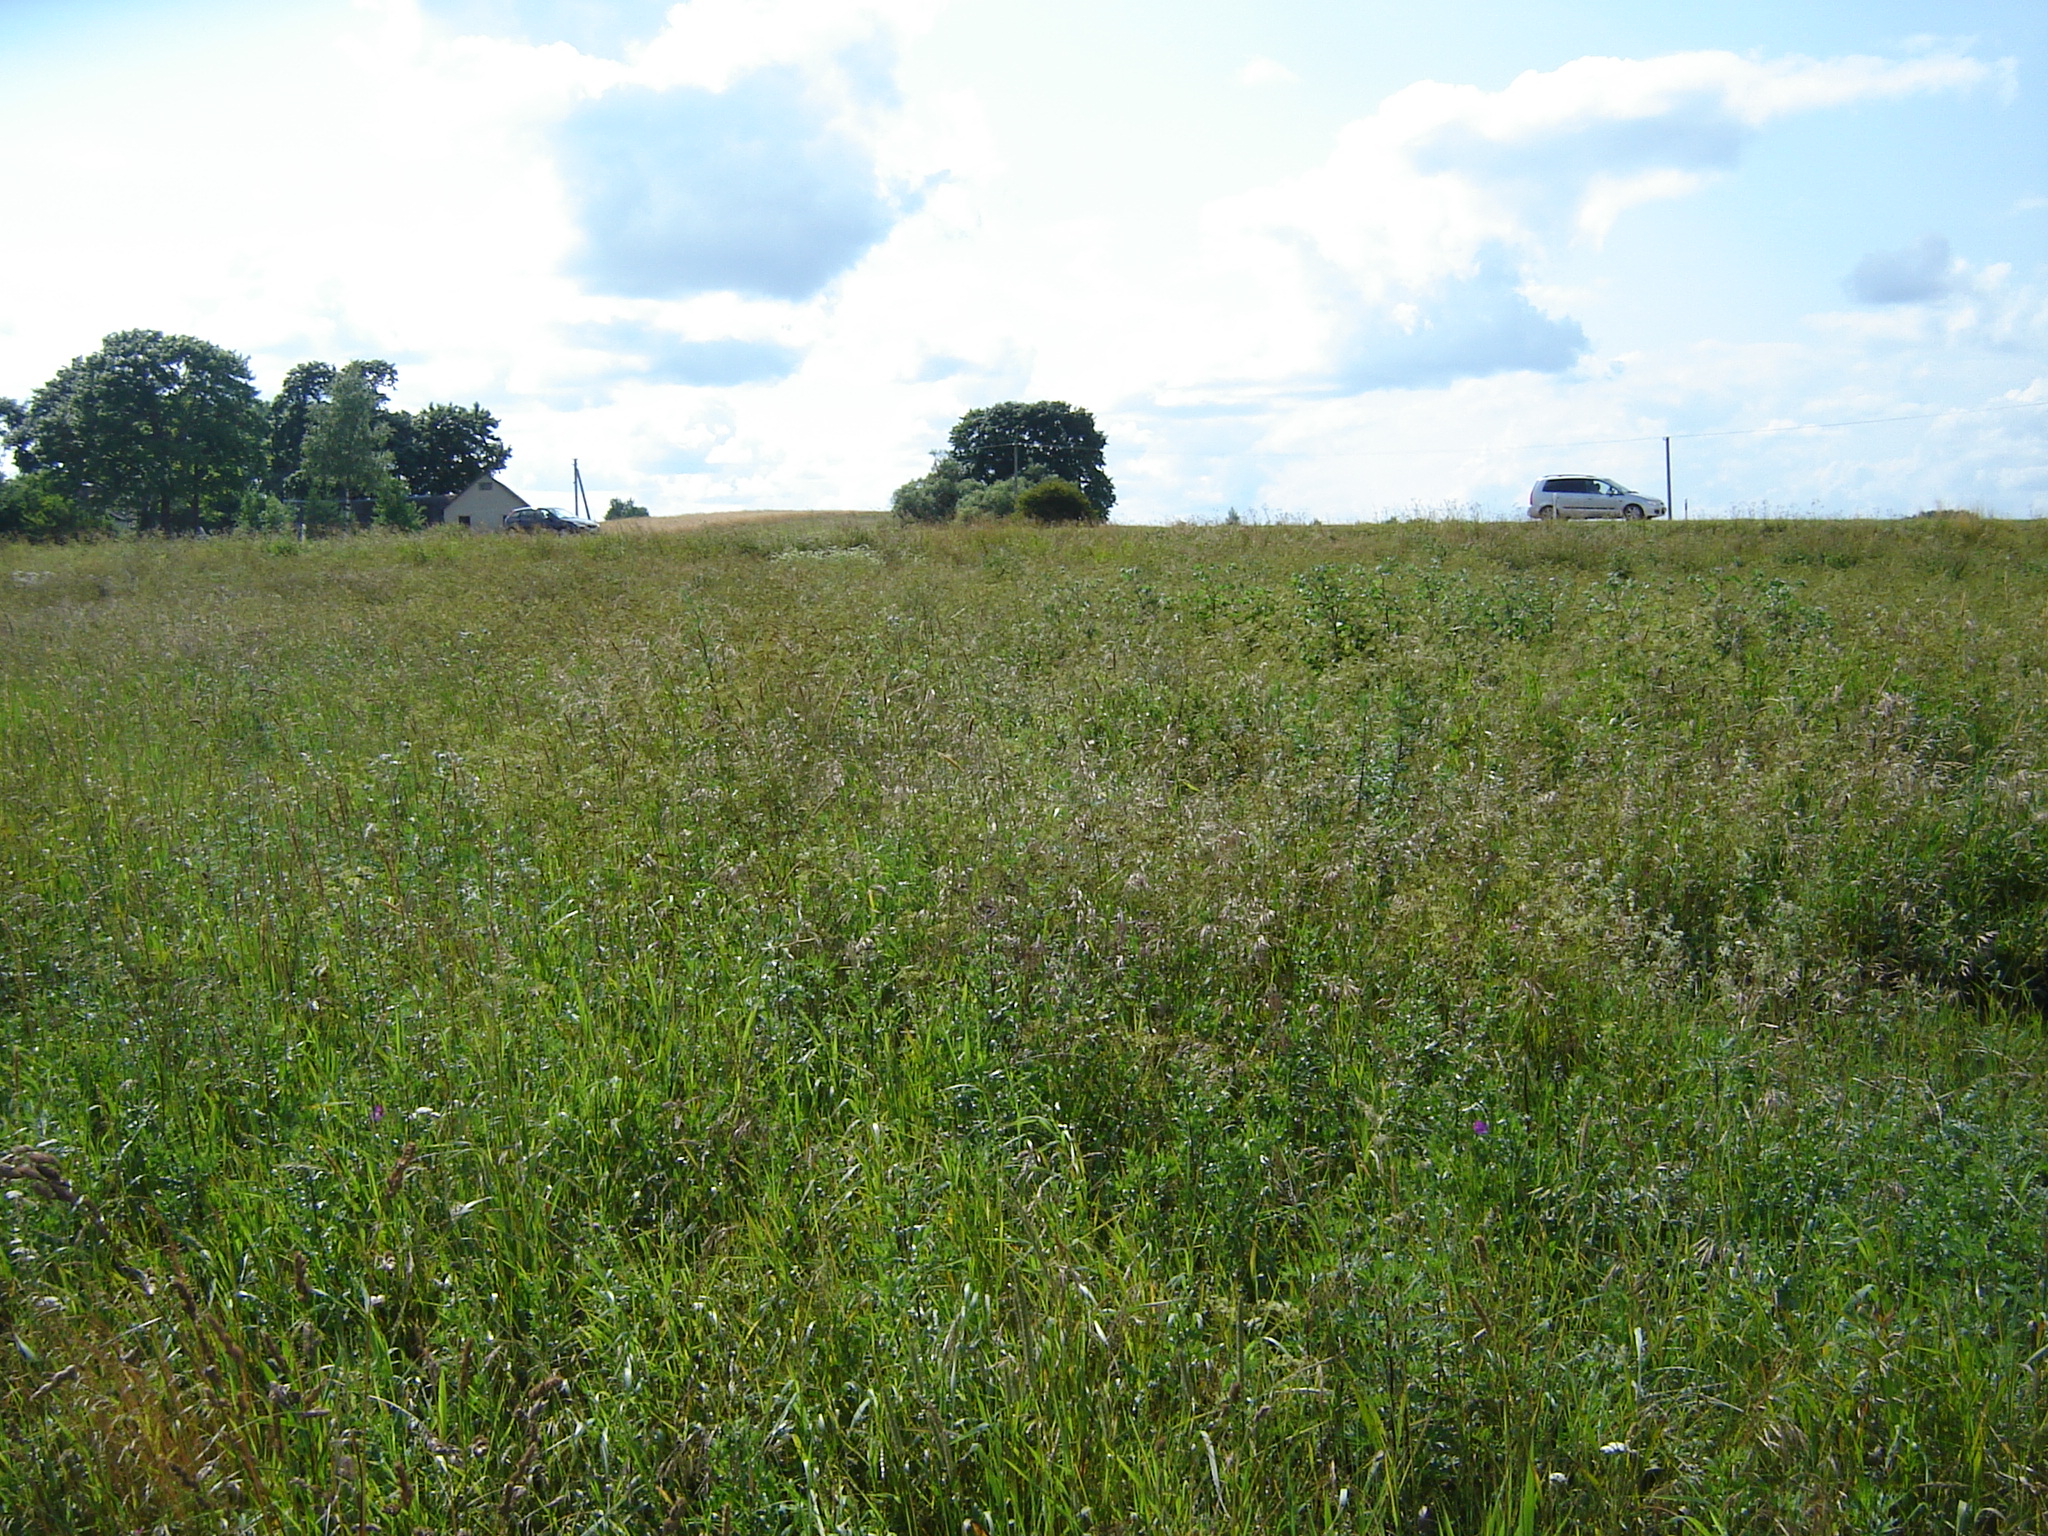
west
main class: Grassland
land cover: Grassland without tree/shrub cover
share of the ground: > 75 %
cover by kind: herbaceous plants 100 %
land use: Agriculture (excluding fallow land and kitchen gardens)
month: July
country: LT
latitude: 55.2425
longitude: 25.4591
